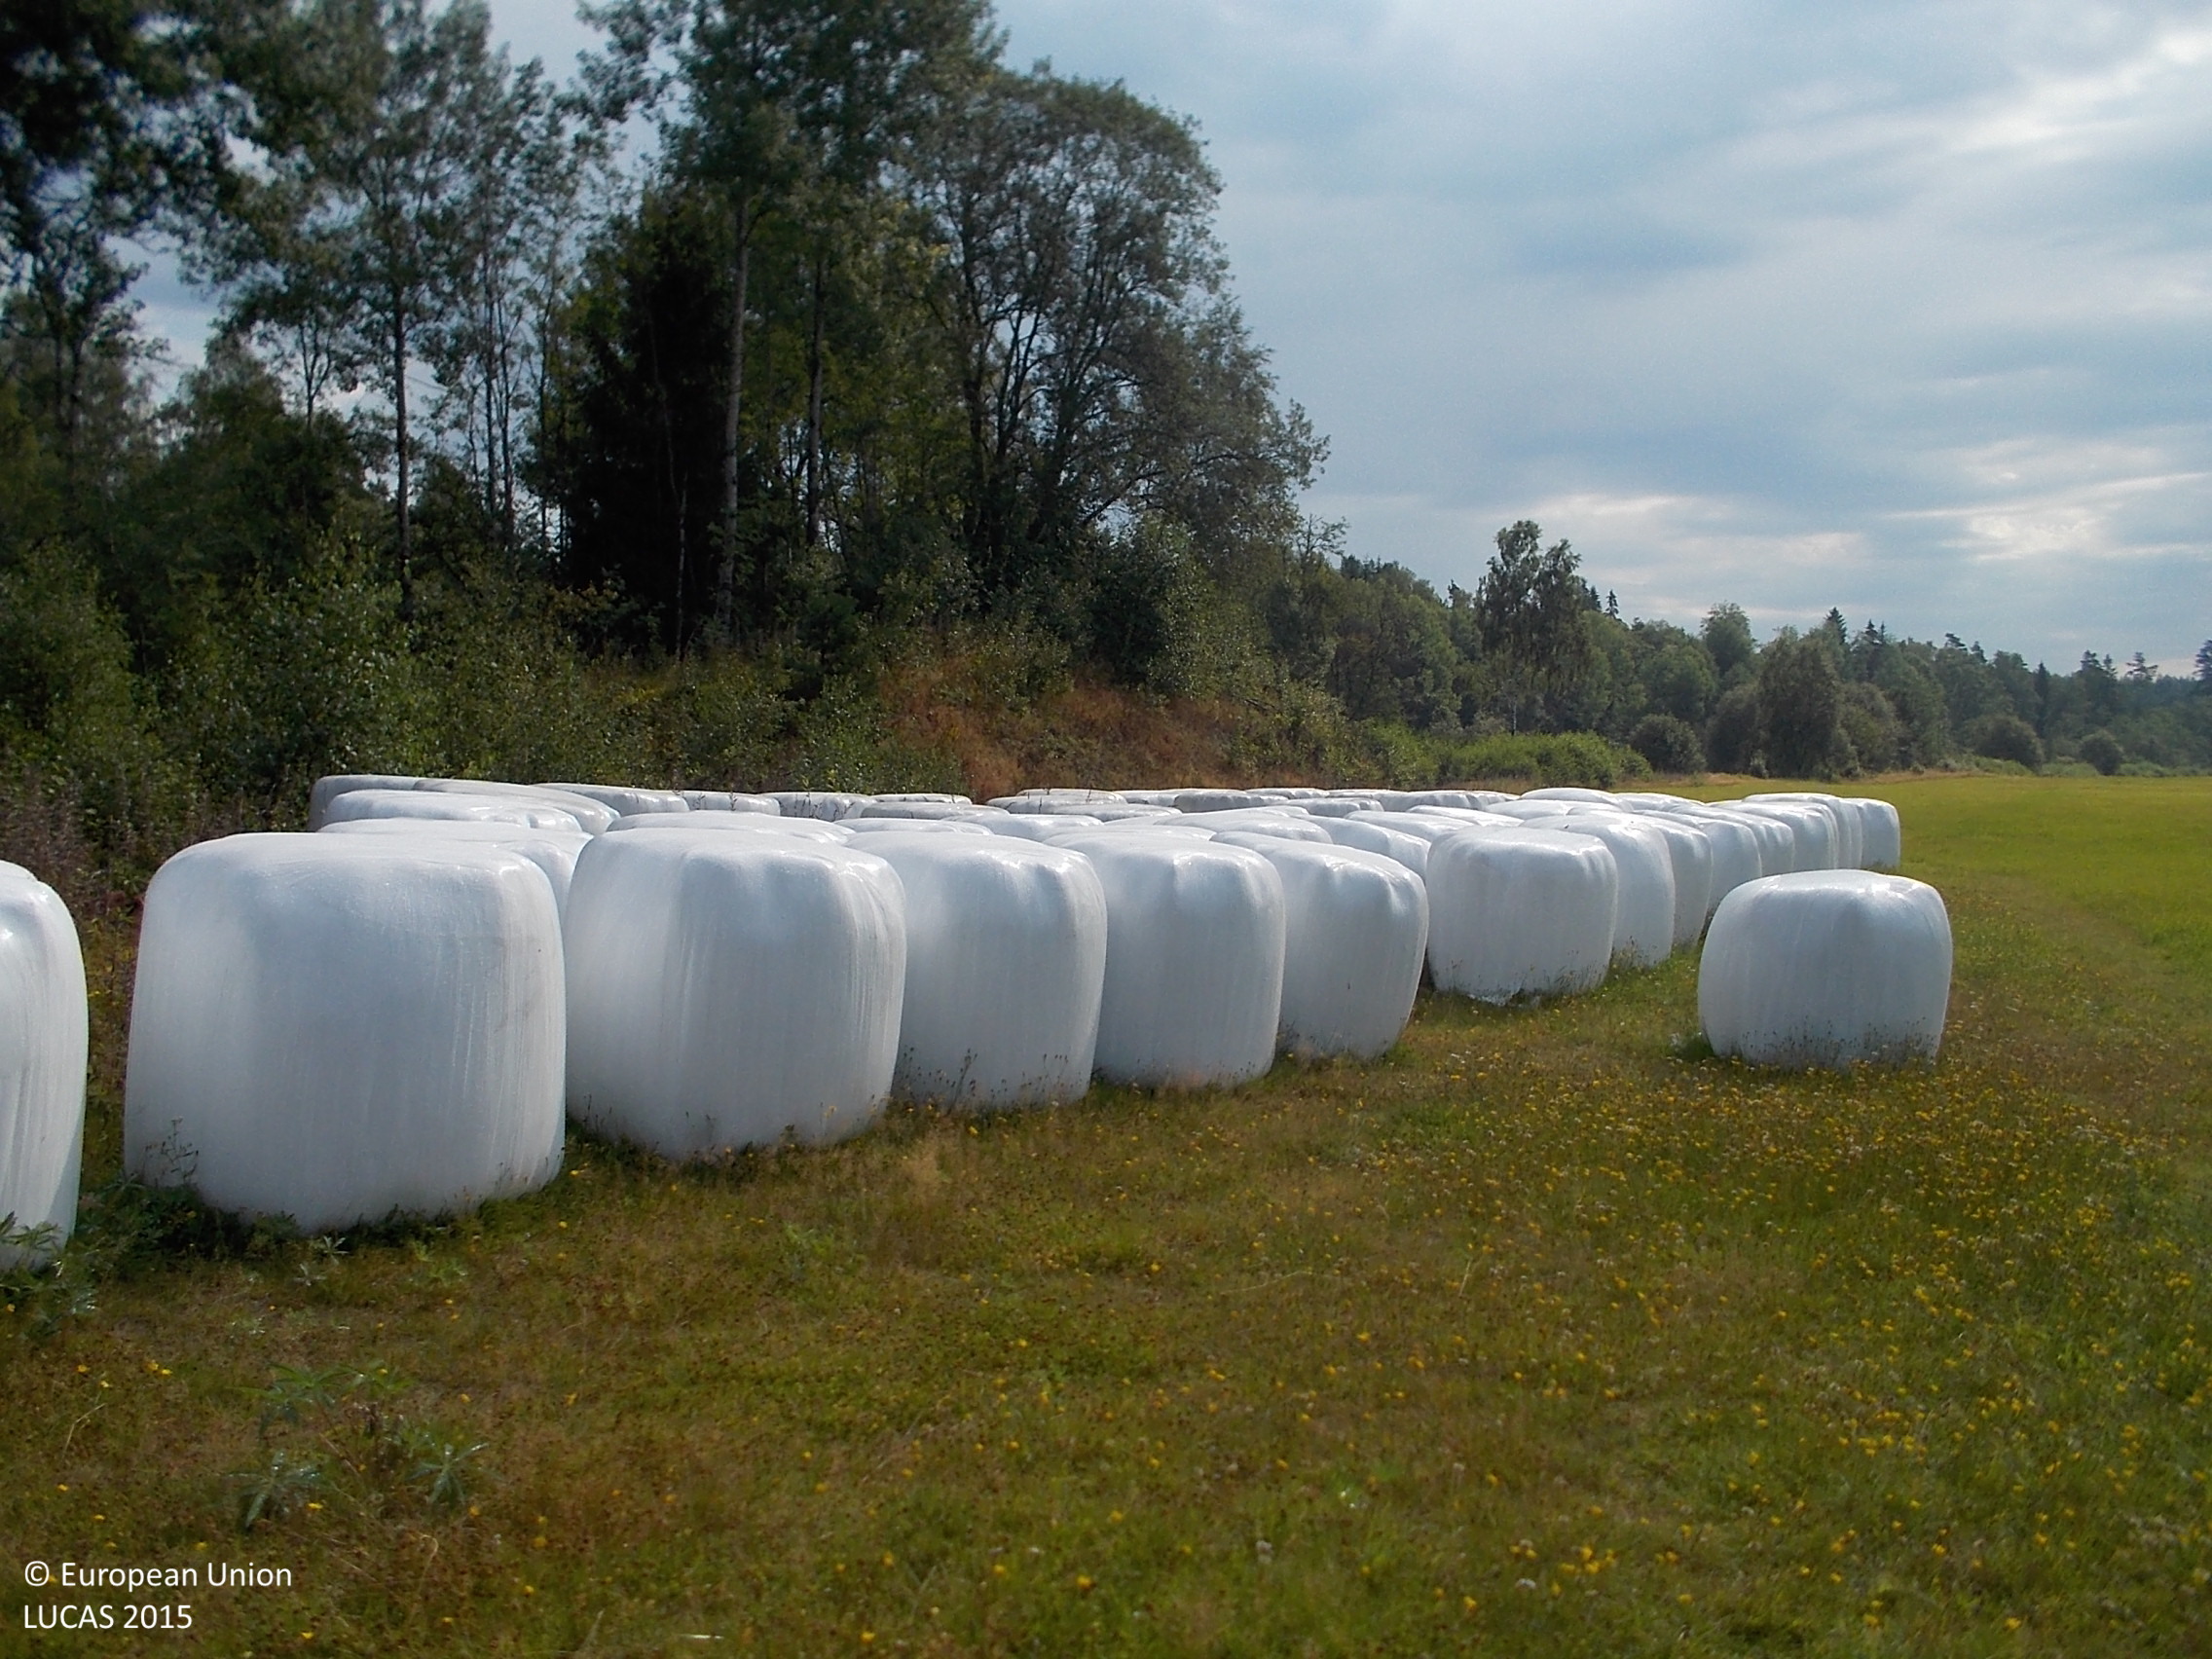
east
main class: Grassland
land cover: Grassland without tree/shrub cover
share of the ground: > 75 %
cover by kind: herbaceous plants 100 %
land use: Agriculture (excluding fallow land and kitchen gardens)
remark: Harvested field
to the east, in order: Grassland without tree/shrub cover; Tracks; Spontaneously vegetated surfaces; Broadleaved woodland; Inland fresh running water; Broadleaved woodland; Spruce dominated mixed woodland; Spruce dominated coniferous woodland
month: August
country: SE
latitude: 57.3925
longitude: 13.0740
